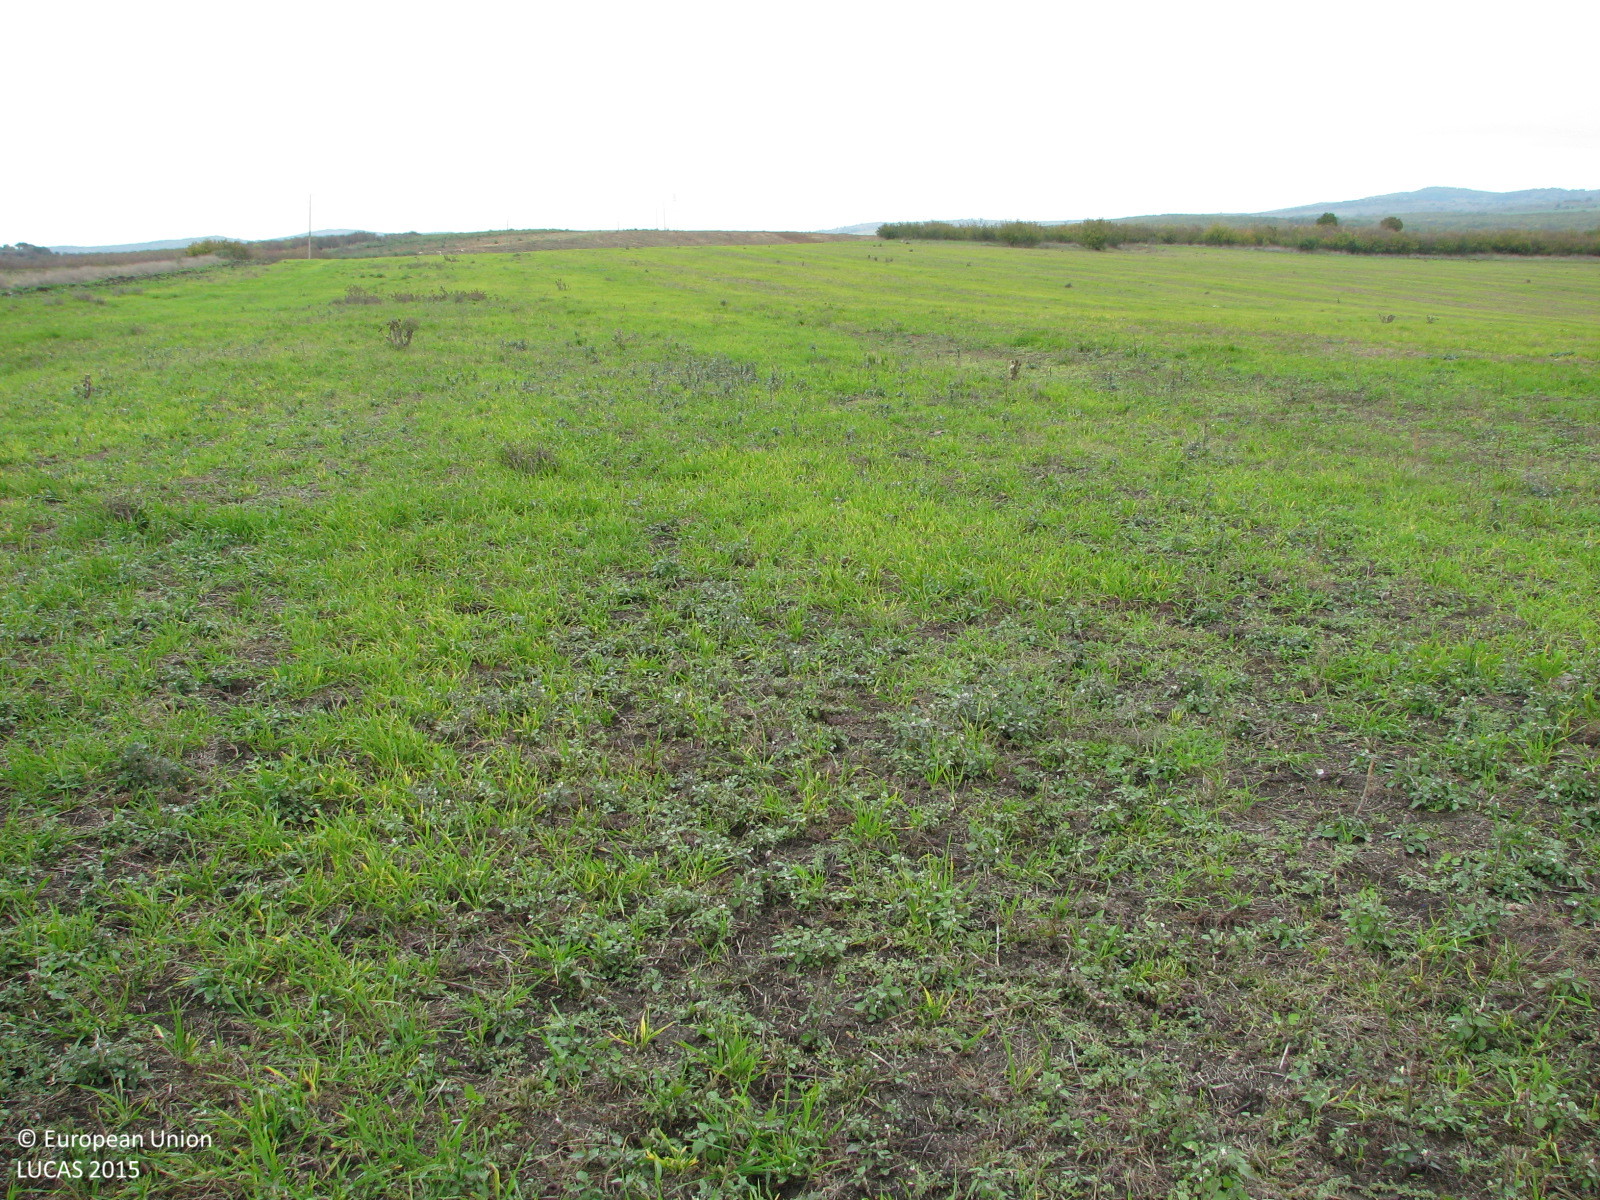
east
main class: Grassland
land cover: Spontaneously vegetated surfaces
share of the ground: > 75 %
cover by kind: herbaceous plants 80 %, unconsolidated bare surface 20 %
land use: Agriculture (excluding fallow land and kitchen gardens)
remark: Harvested field
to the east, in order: Spontaneously vegetated surfaces; Grassland without tree/shrub cover; Broadleaved woodland; Shrubland without tree cover
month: October
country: BG
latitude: 42.2224
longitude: 26.7530
